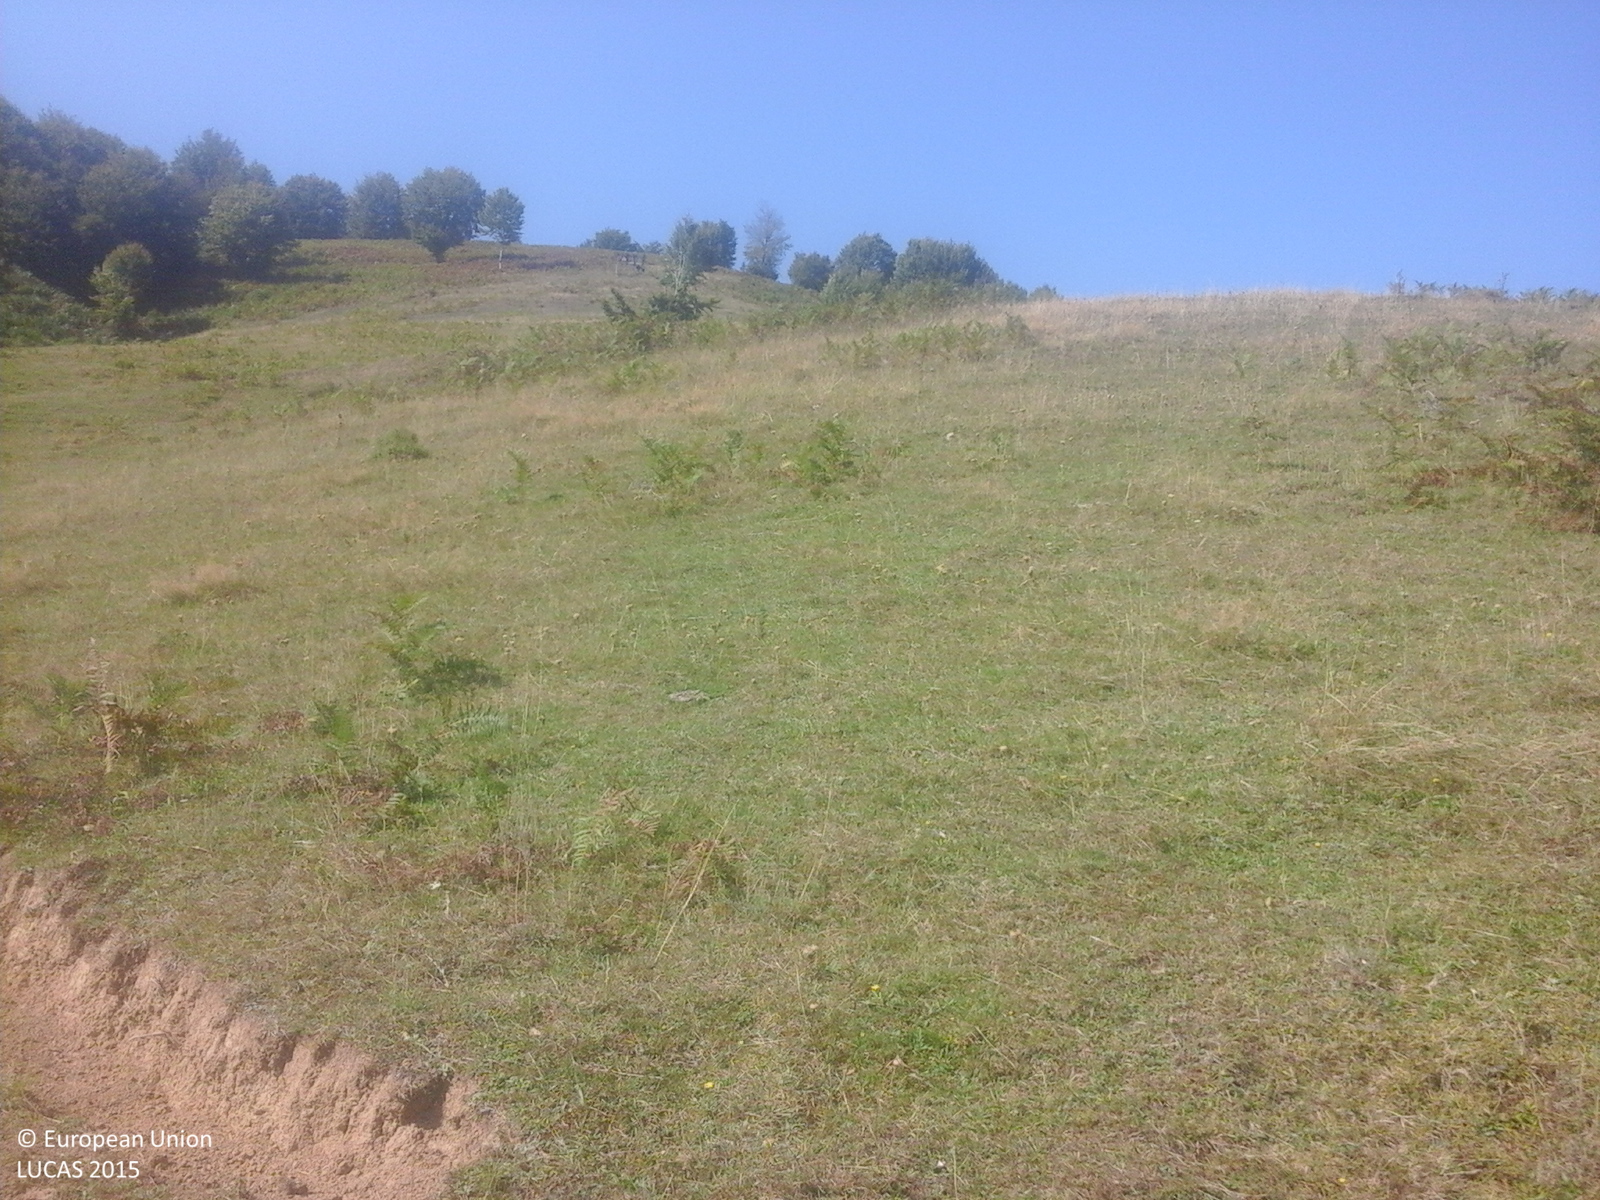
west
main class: Grassland
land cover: Grassland without tree/shrub cover
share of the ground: > 75 %
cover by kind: herbaceous plants 100 %
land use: Agriculture (excluding fallow land and kitchen gardens)
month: September
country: RO
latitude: 46.8121
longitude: 22.3836
